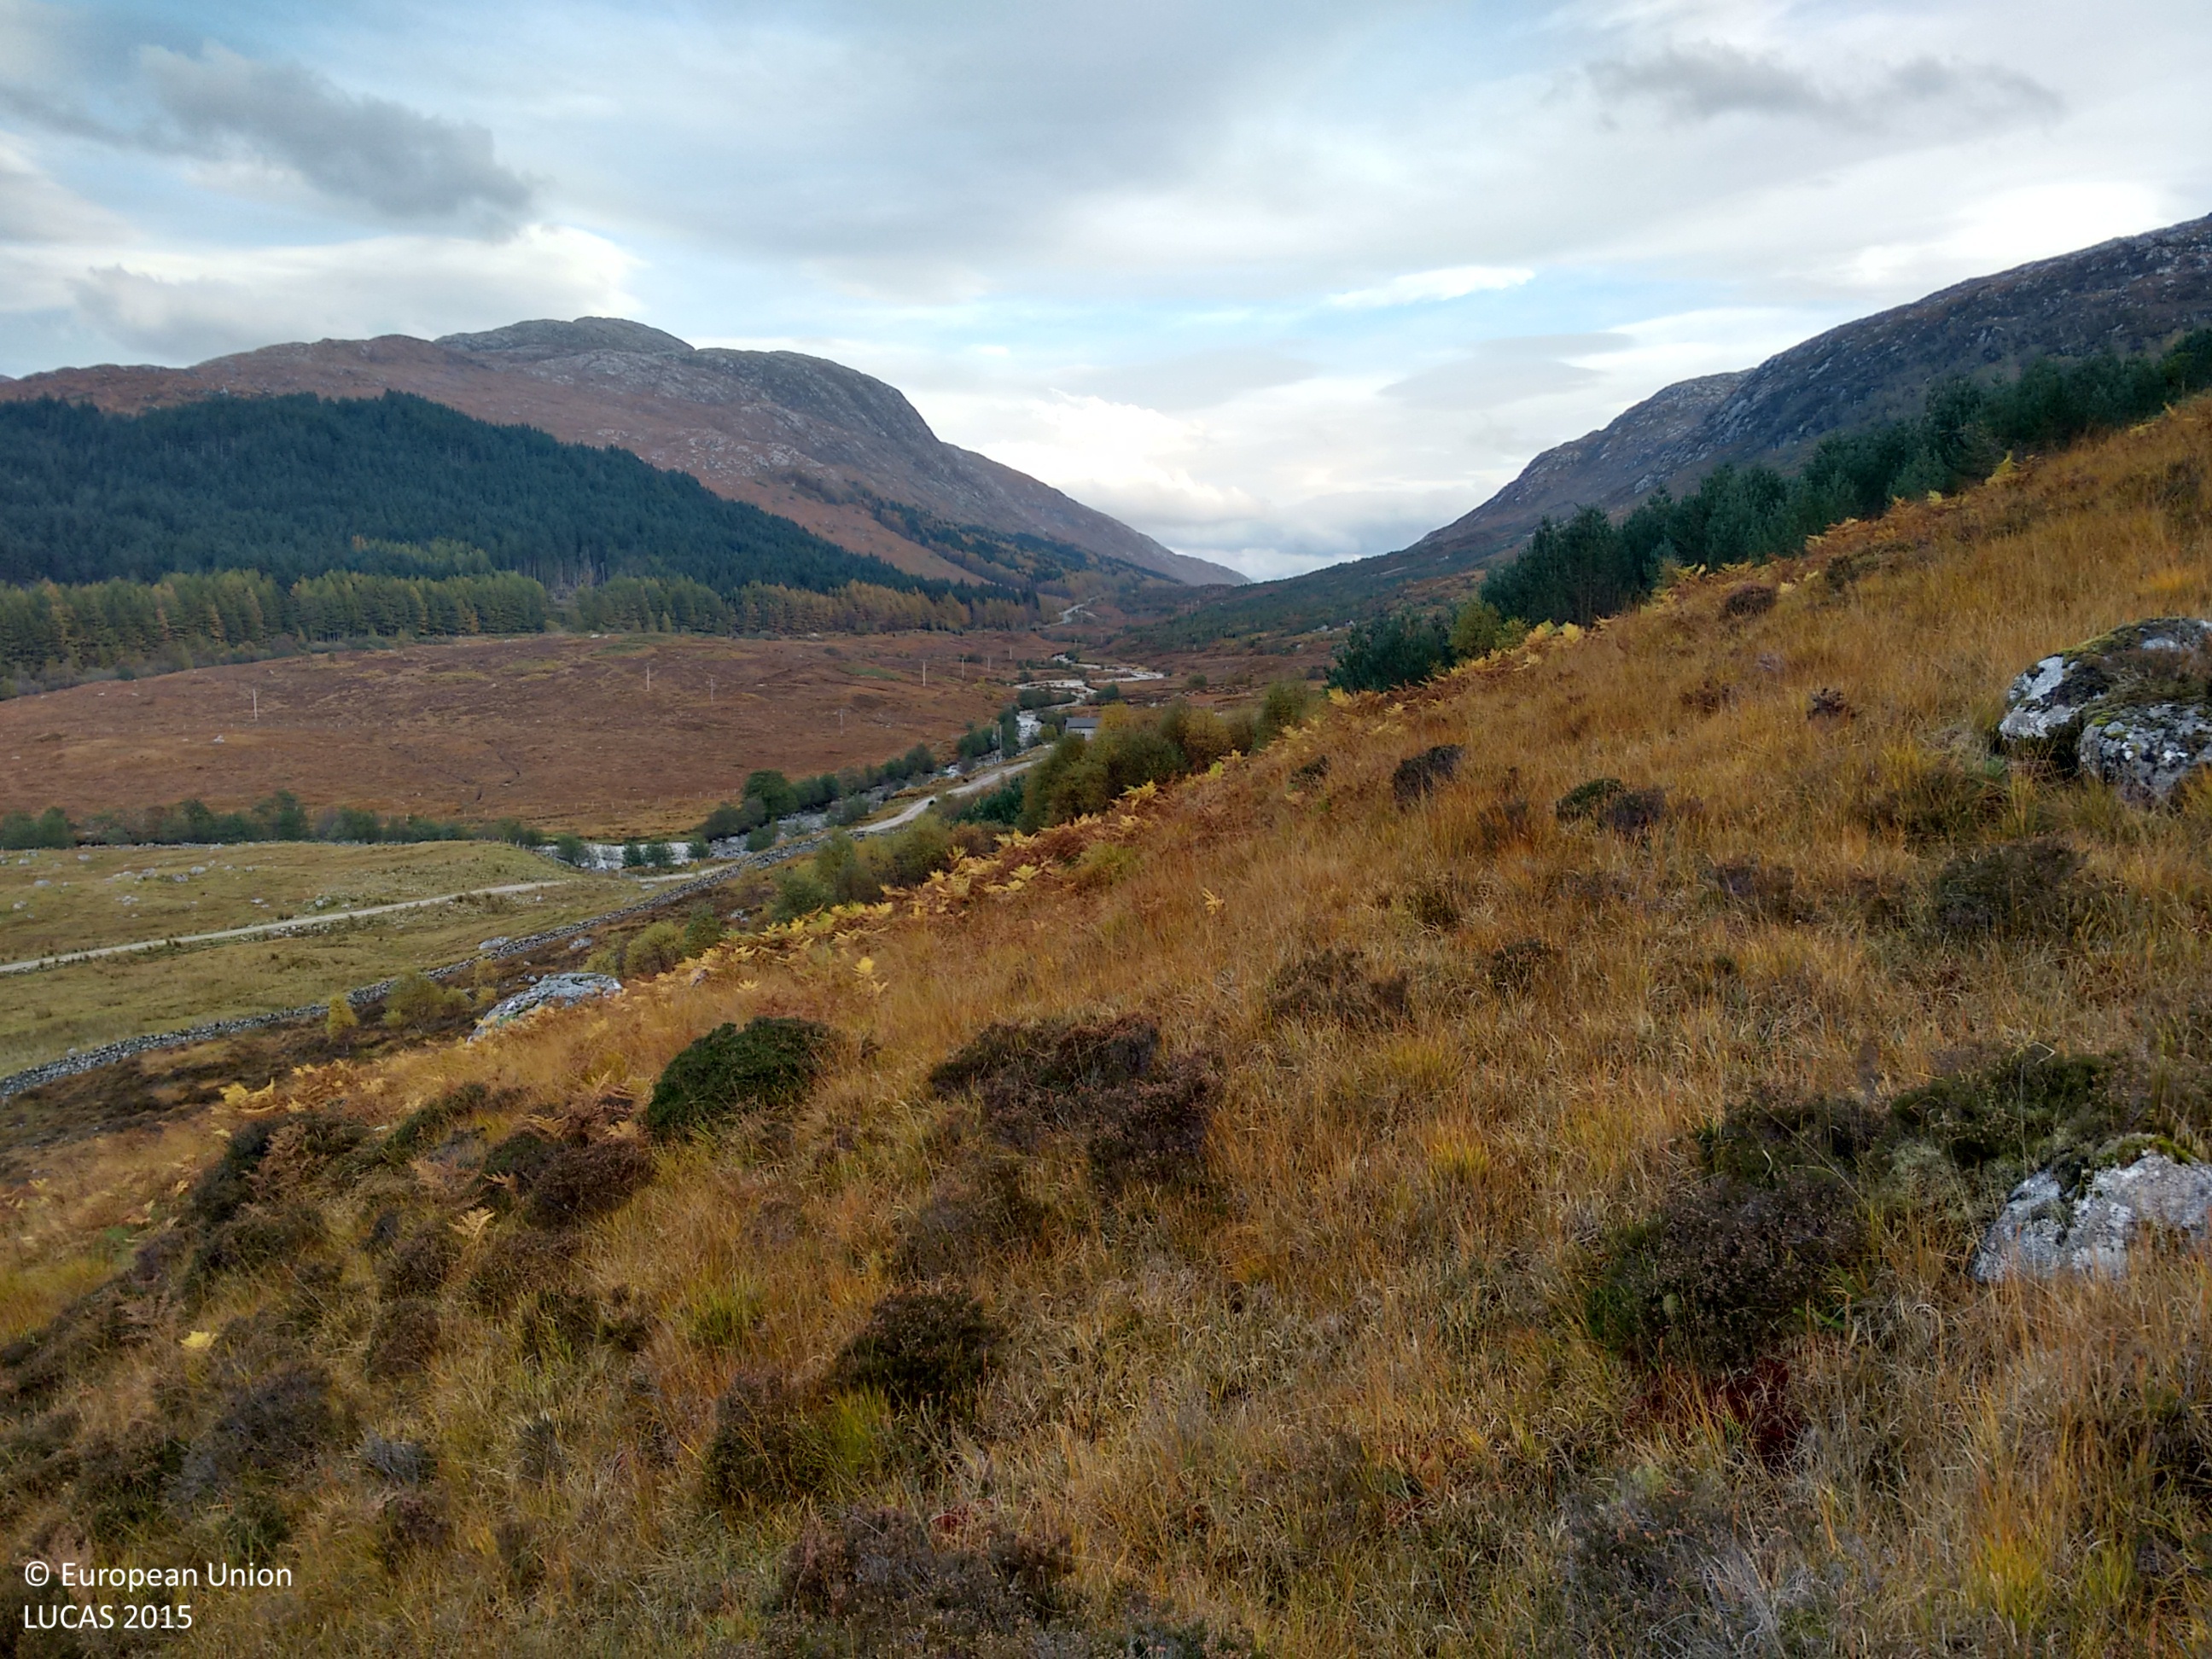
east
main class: Shrubland
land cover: Shrubland without tree cover
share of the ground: > 75 %
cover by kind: shrubs 60 %, herbaceous plants 30 %, lichens and mosses 5 %
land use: Agriculture (excluding fallow land and kitchen gardens)
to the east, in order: Shrubland without tree cover; Rock outcrops; Shrubland without tree cover; Pine dominated mixed woodland; Shrubland with sparse tree cover; Broadleaved woodland; Pine dominated mixed woodland; Broadleaved woodland
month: October
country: GB
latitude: 56.6857
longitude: -5.5144
